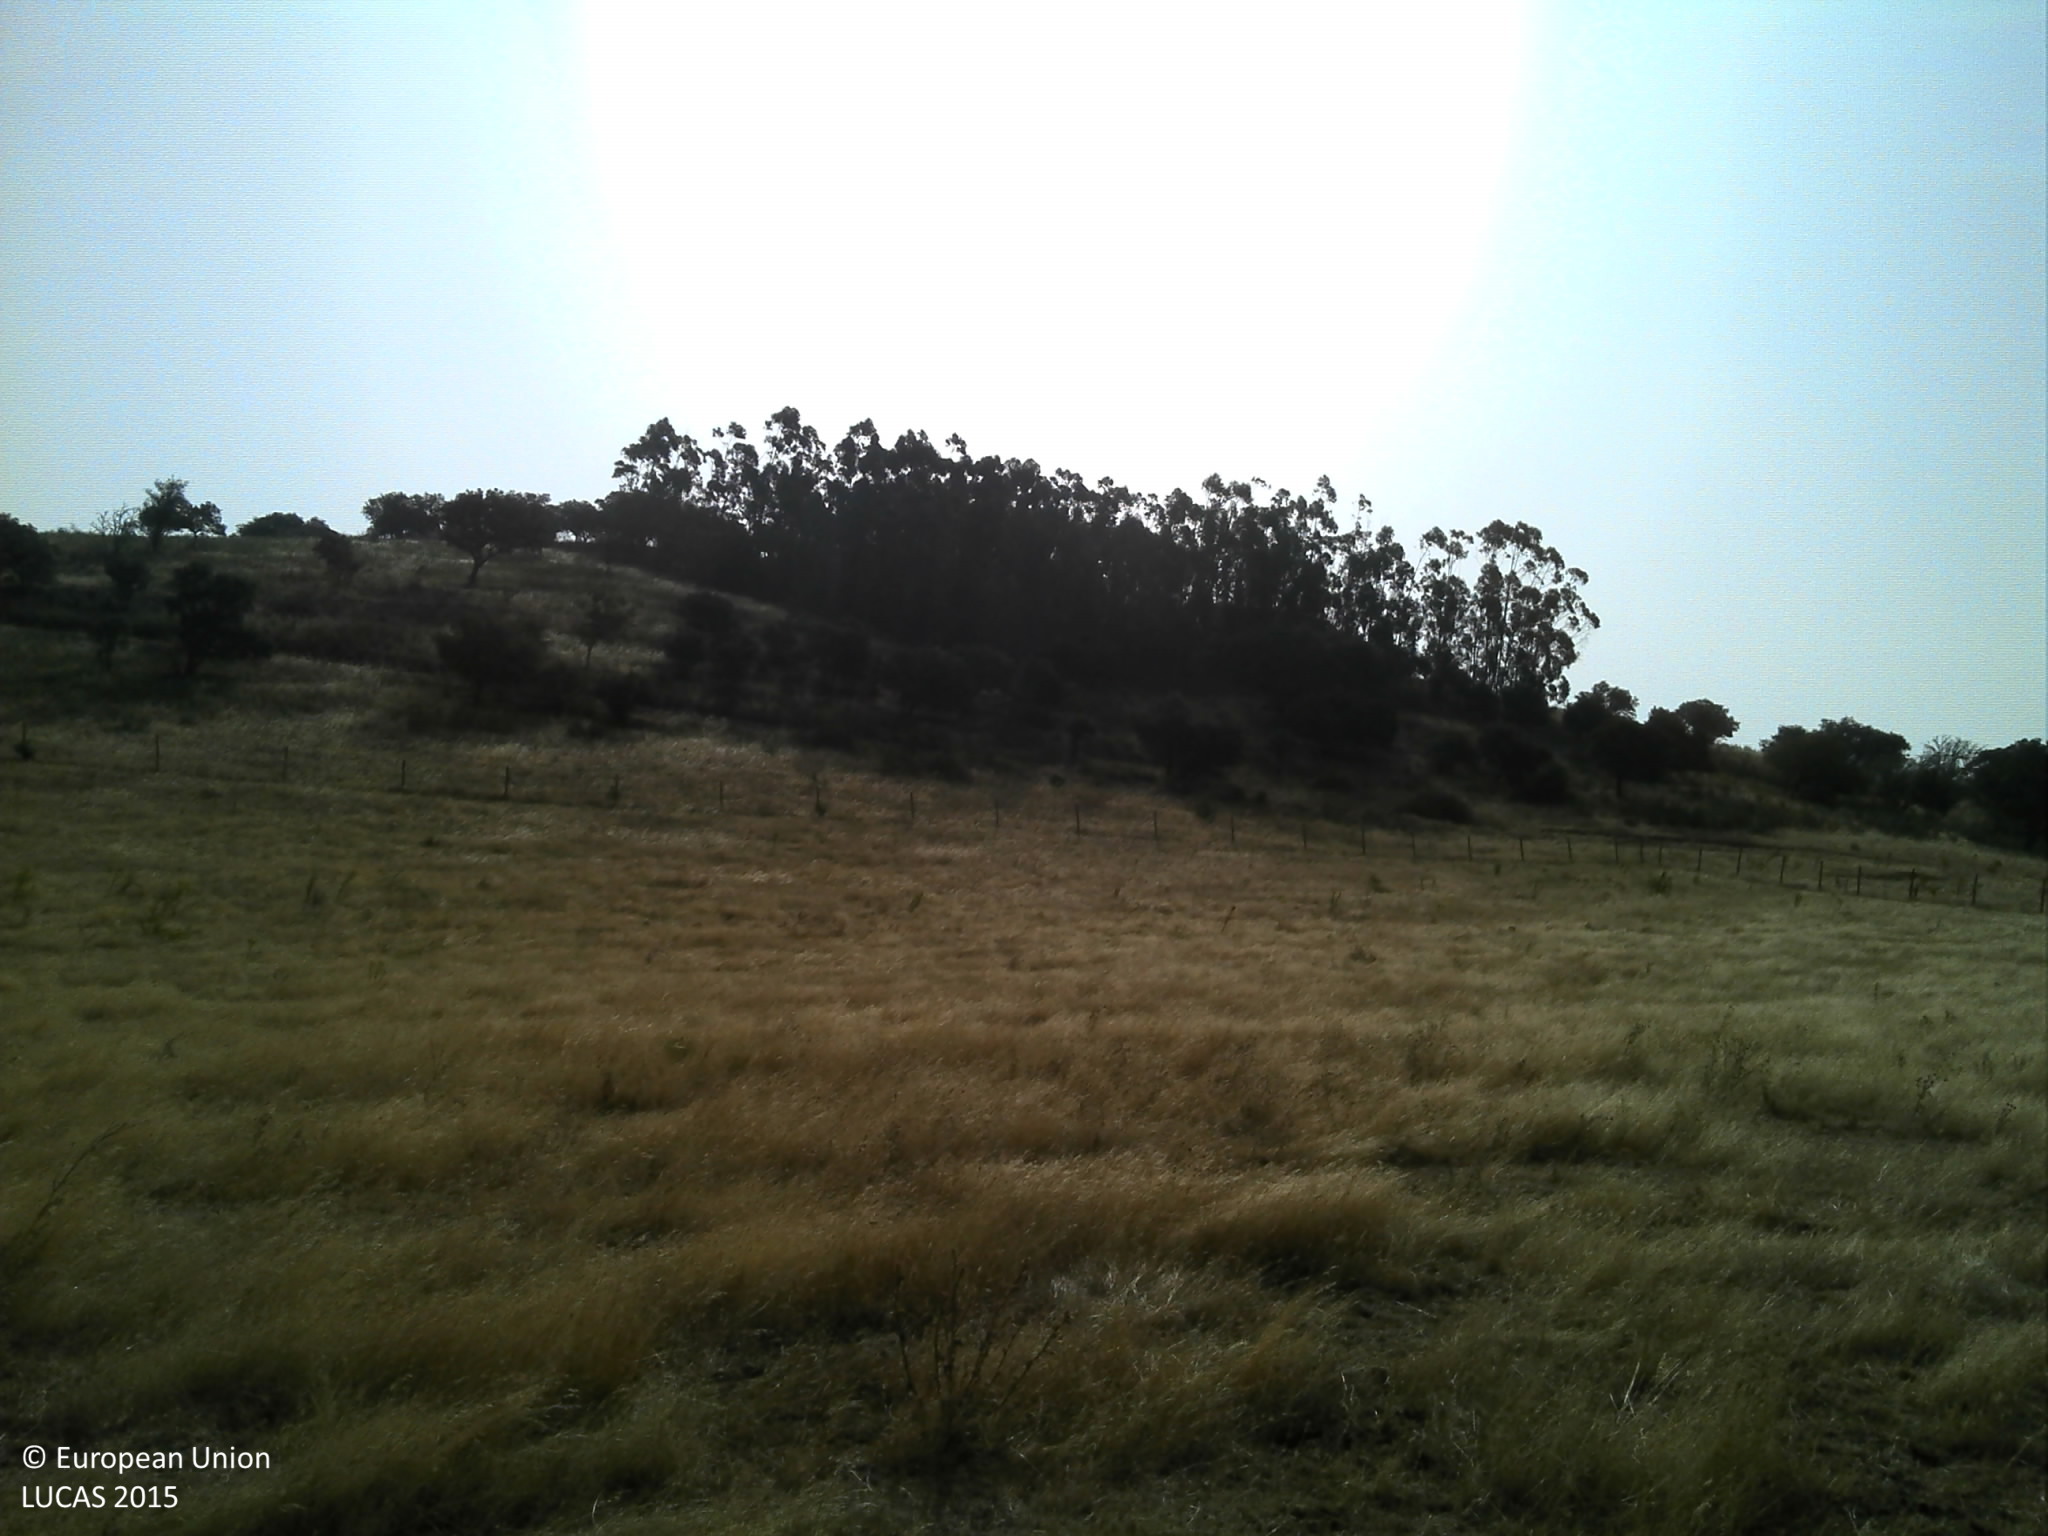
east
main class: Grassland
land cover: Grassland without tree/shrub cover
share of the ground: 25 - 50 %
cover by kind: unconsolidated bare surface 60 %, herbaceous plants 40 %
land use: Agriculture (excluding fallow land and kitchen gardens)
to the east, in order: Grassland without tree/shrub cover; Fences; Grassland without tree/shrub cover; Tracks; Broadleaved woodland; Fences; Shrubland without tree cover
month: July
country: PT
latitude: 38.7077
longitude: -7.4531
